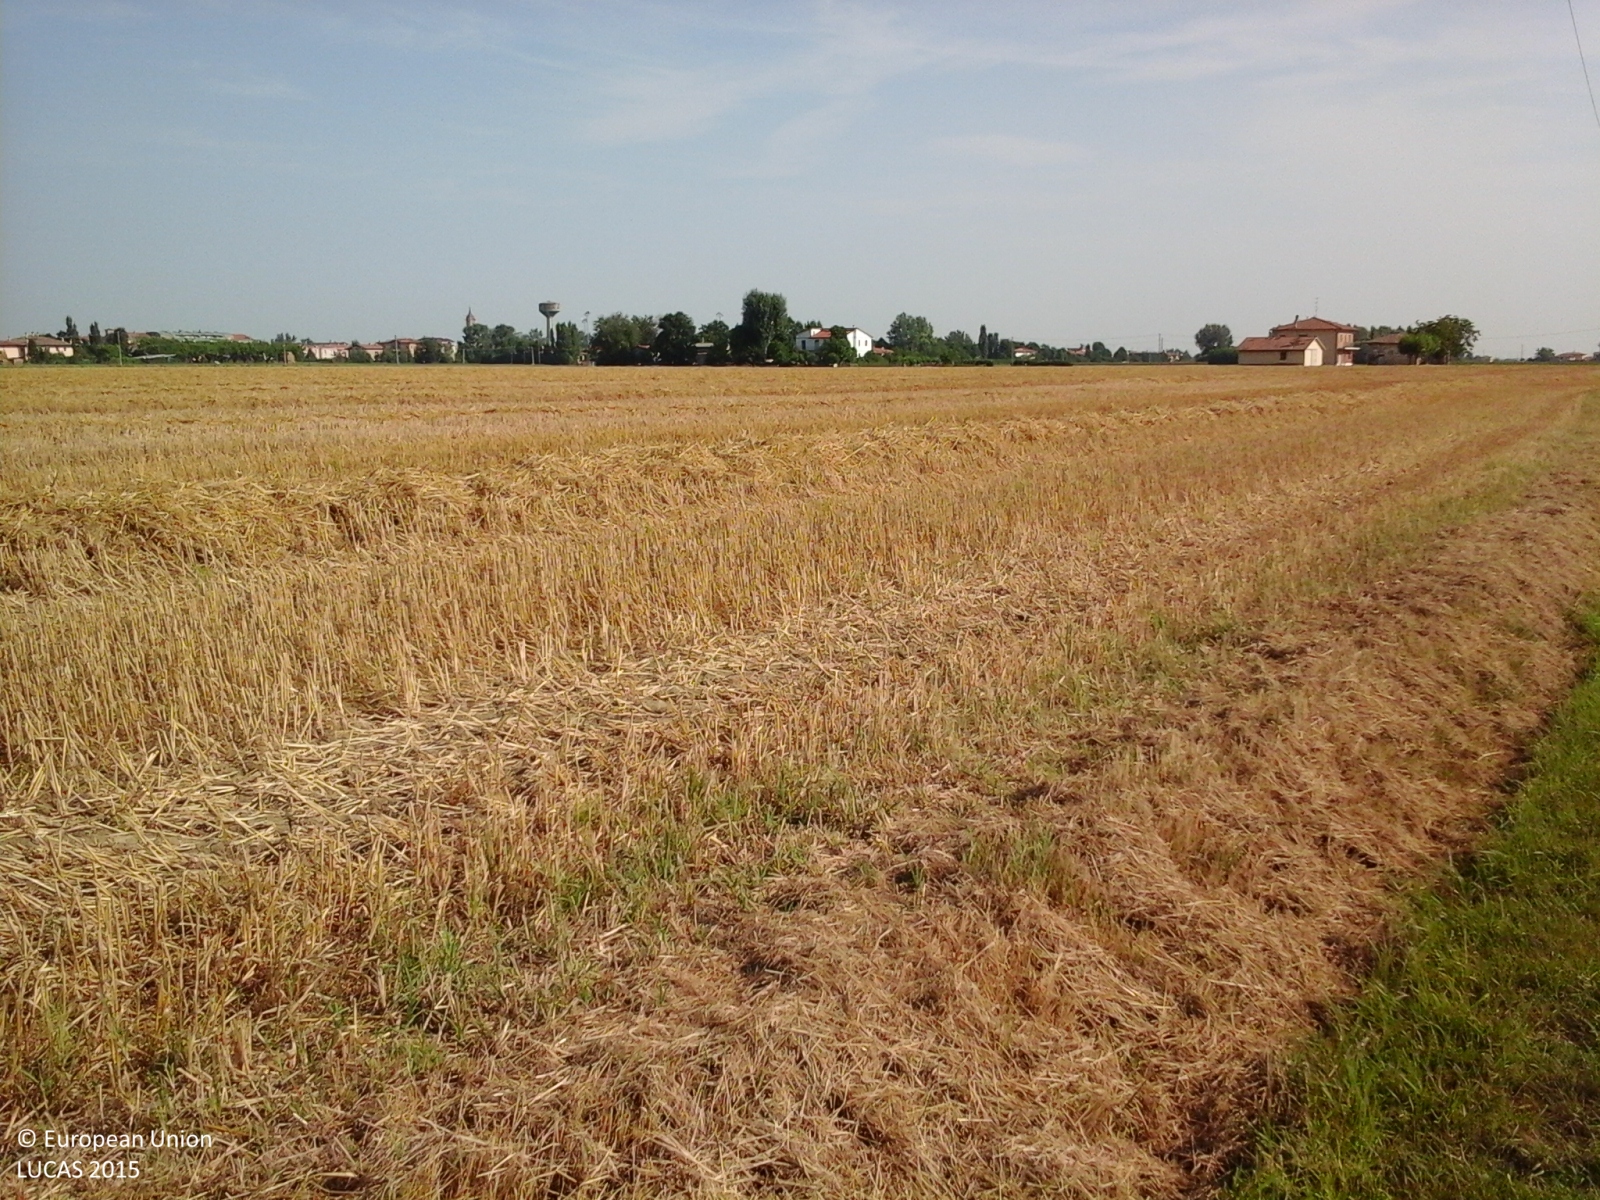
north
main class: Cropland
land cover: Barley
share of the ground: > 75 %
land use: Agriculture (excluding fallow land and kitchen gardens)
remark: Harvested field
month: July
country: IT
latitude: 44.4638
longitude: 11.6430
